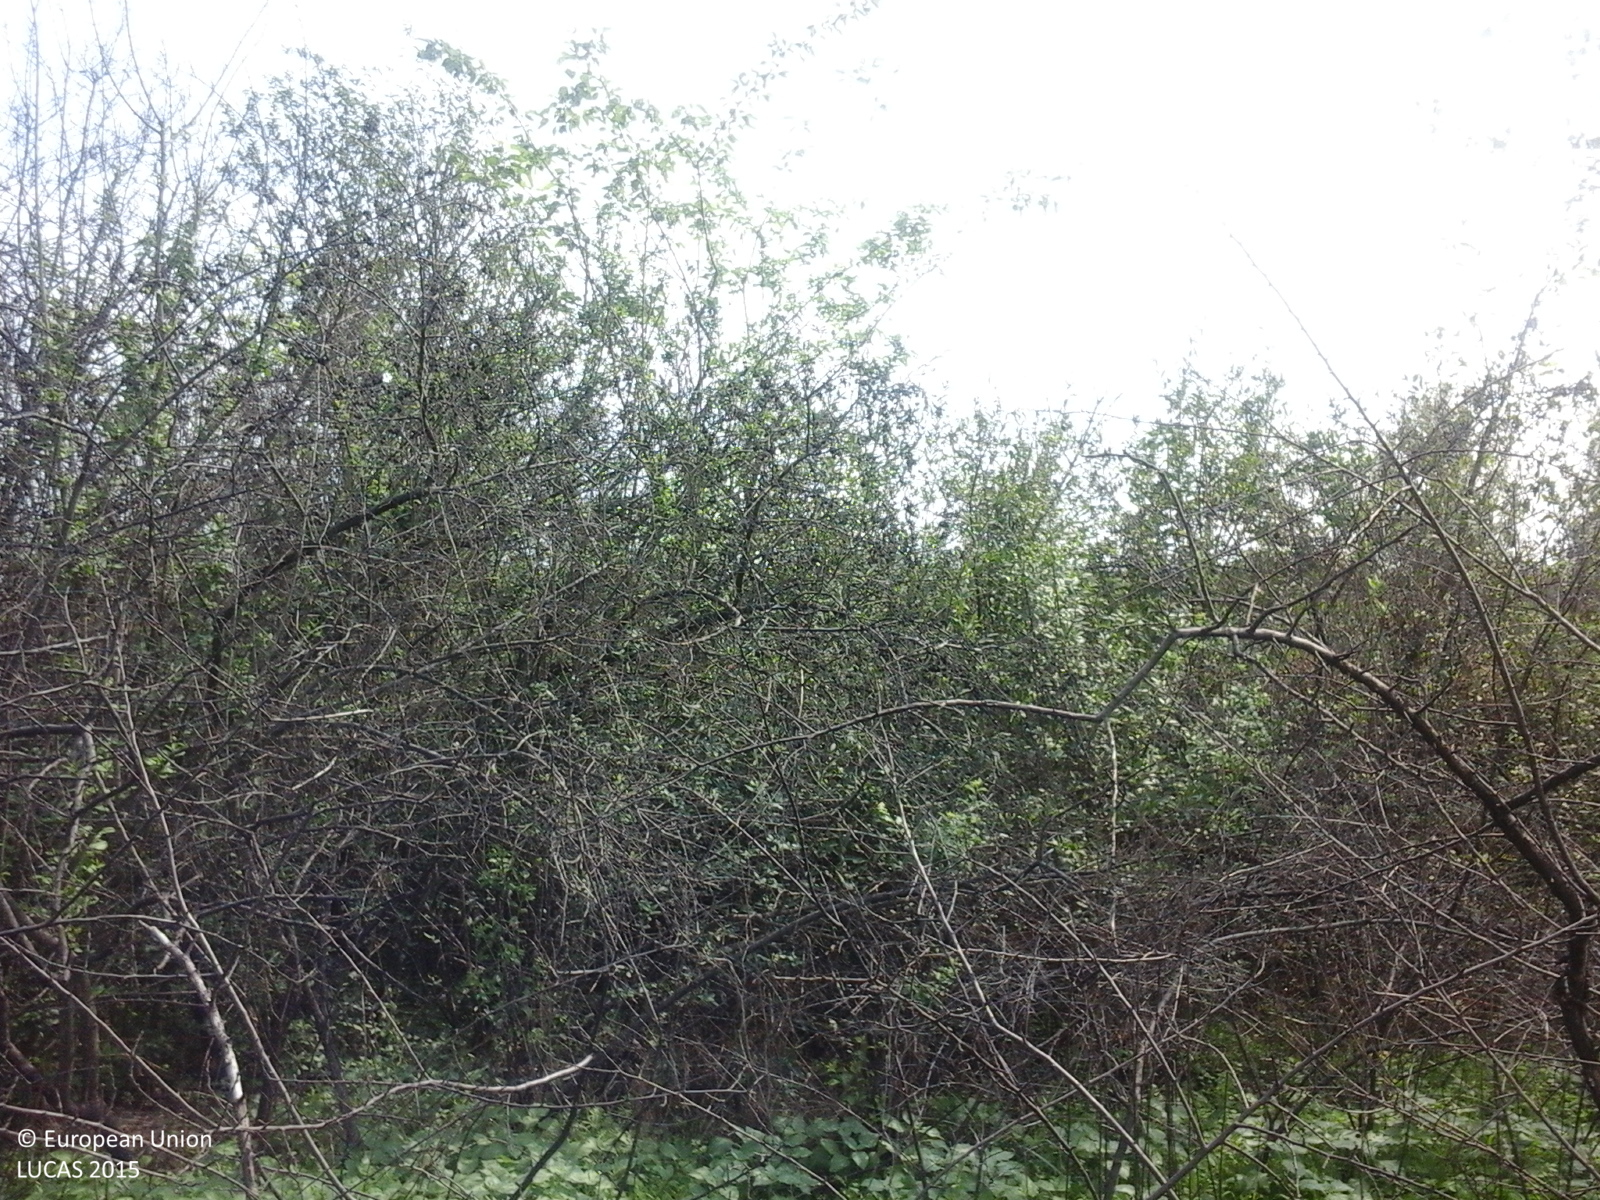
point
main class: Shrubland
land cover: Shrubland with sparse tree cover
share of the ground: > 75 %
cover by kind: shrubs 95 %, broadleaved forest trees 5 %
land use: Semi-natural and natural areas not in use
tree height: > 5 m
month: September
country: RO
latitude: 44.9780
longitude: 23.2283
